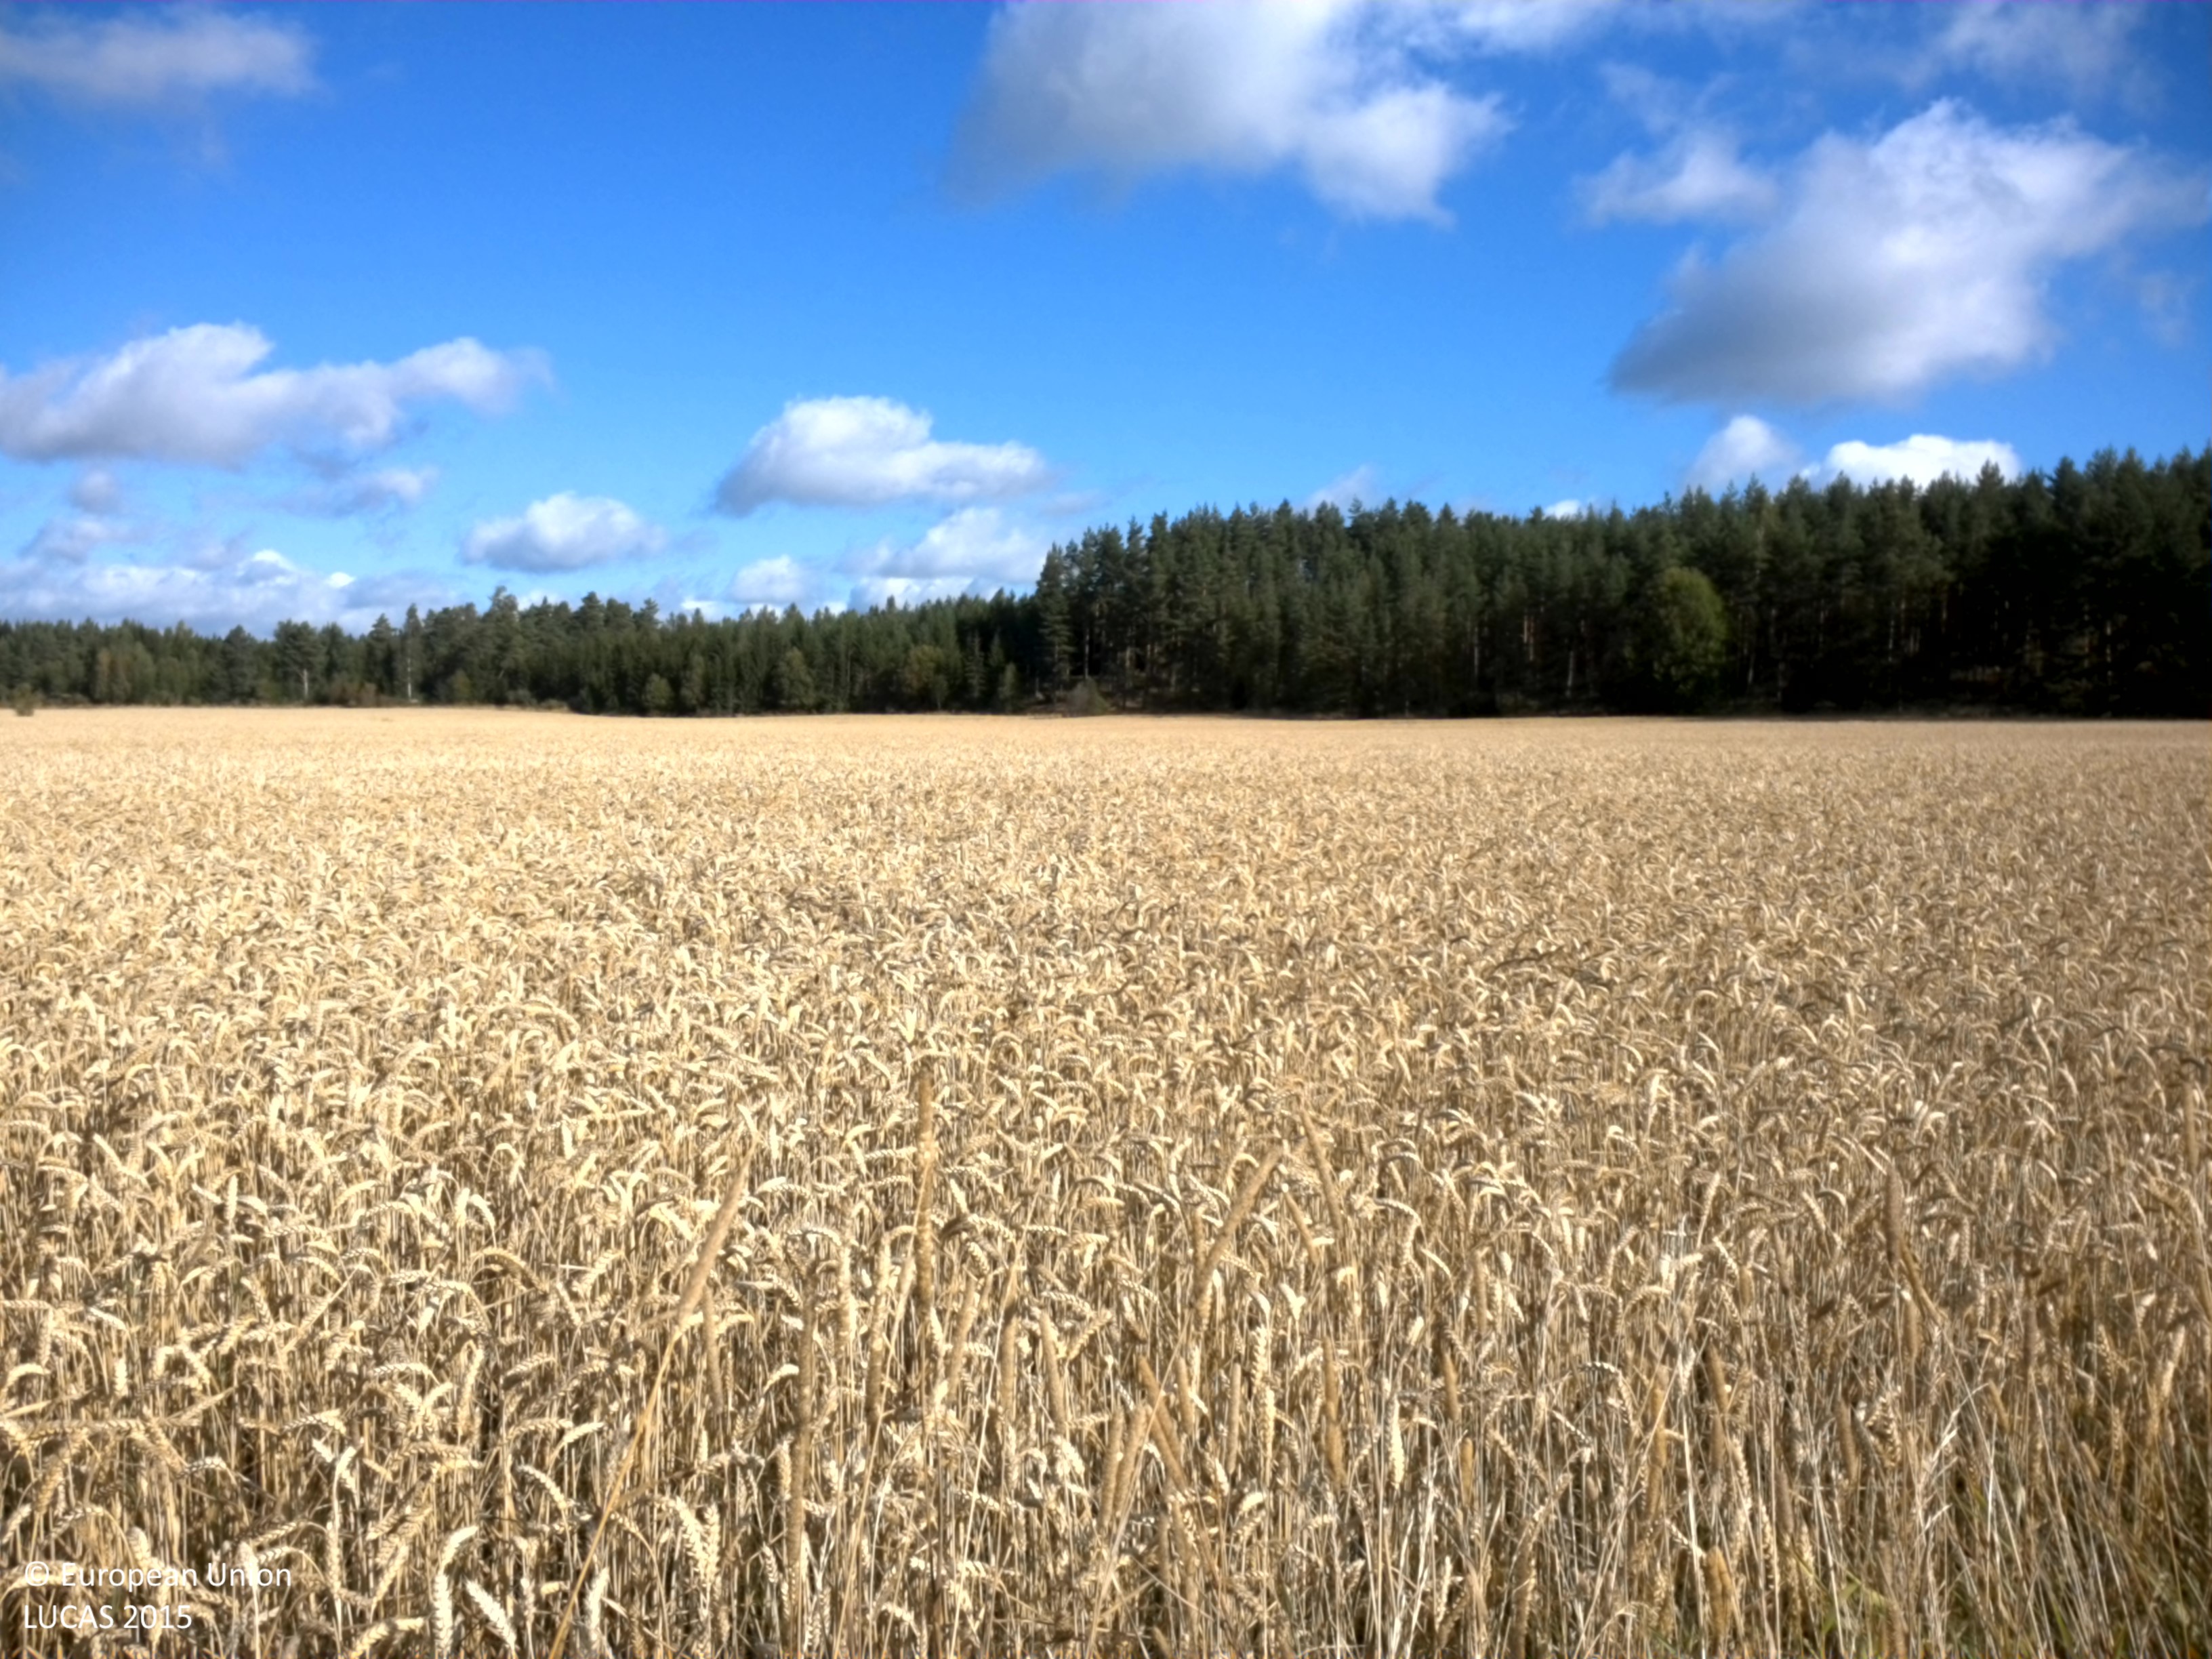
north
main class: Cropland
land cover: Common wheat
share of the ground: > 75 %
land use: Agriculture (excluding fallow land and kitchen gardens)
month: August
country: SE
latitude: 59.7722
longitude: 16.9911
